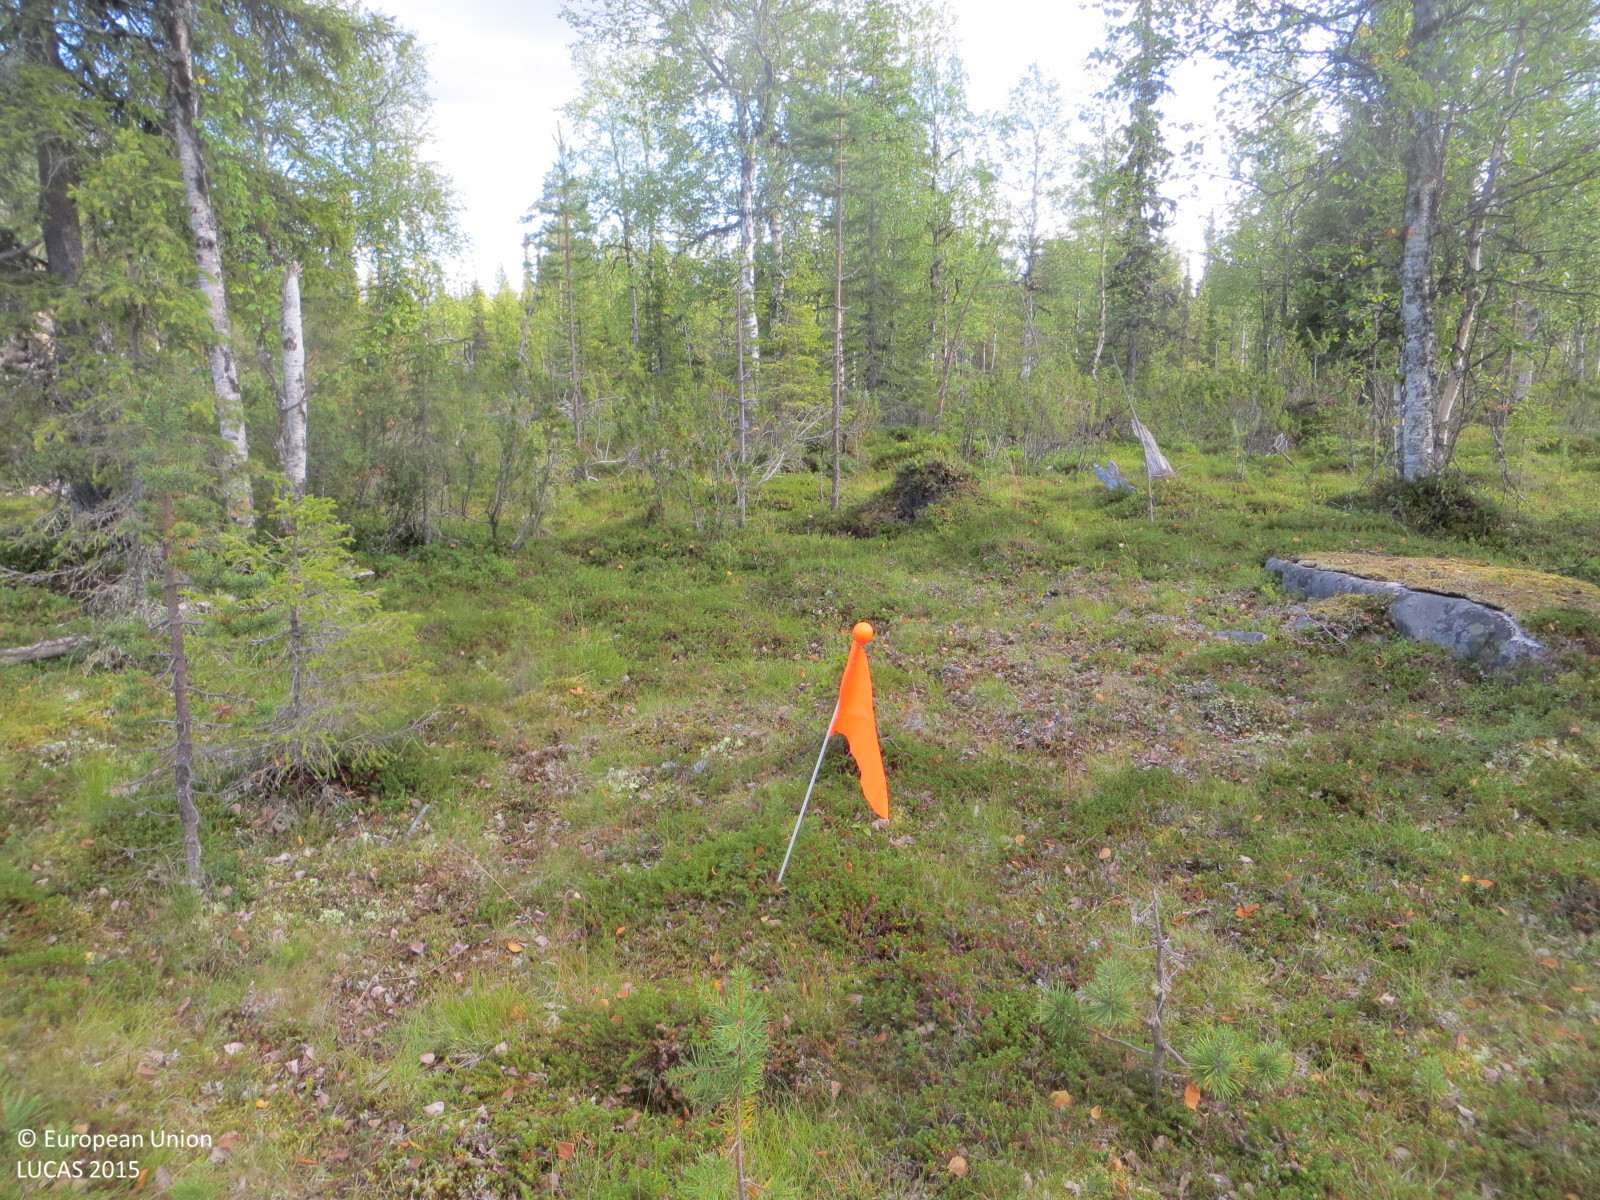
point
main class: Woodland
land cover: Other mixed woodland
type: hemiboreal forest and nemoral coniferous forest and mixed broadleaved-coniferous forest
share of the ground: 50 - 75 %
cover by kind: shrubs 50 %, coniferous forest trees 25 %, broadleaved forest trees 25 %
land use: Forestry
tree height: > 5 m
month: August
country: FI
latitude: 68.0461
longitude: 25.6469
